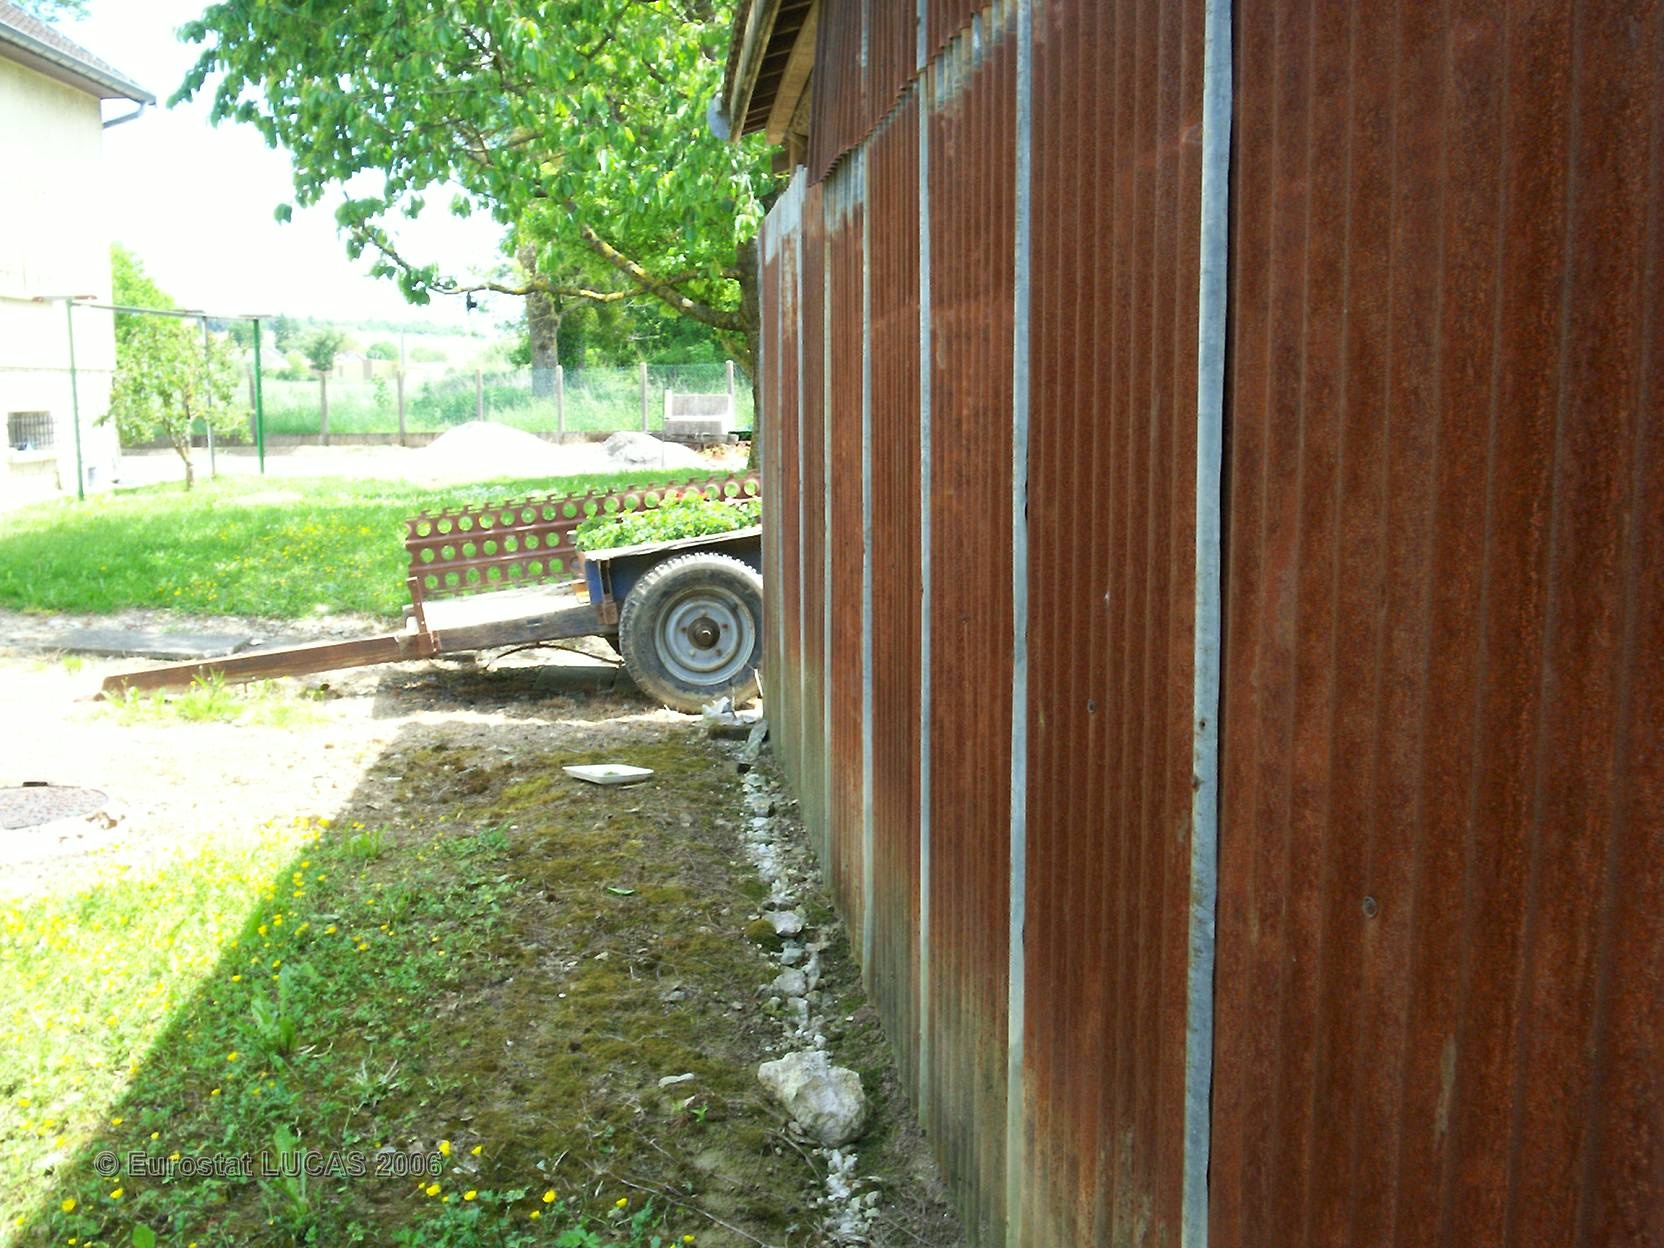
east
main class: Grassland
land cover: Grassland with sparse tree/shrub cover
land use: Residential
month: March
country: FR
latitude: 48.1431
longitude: 4.5548
